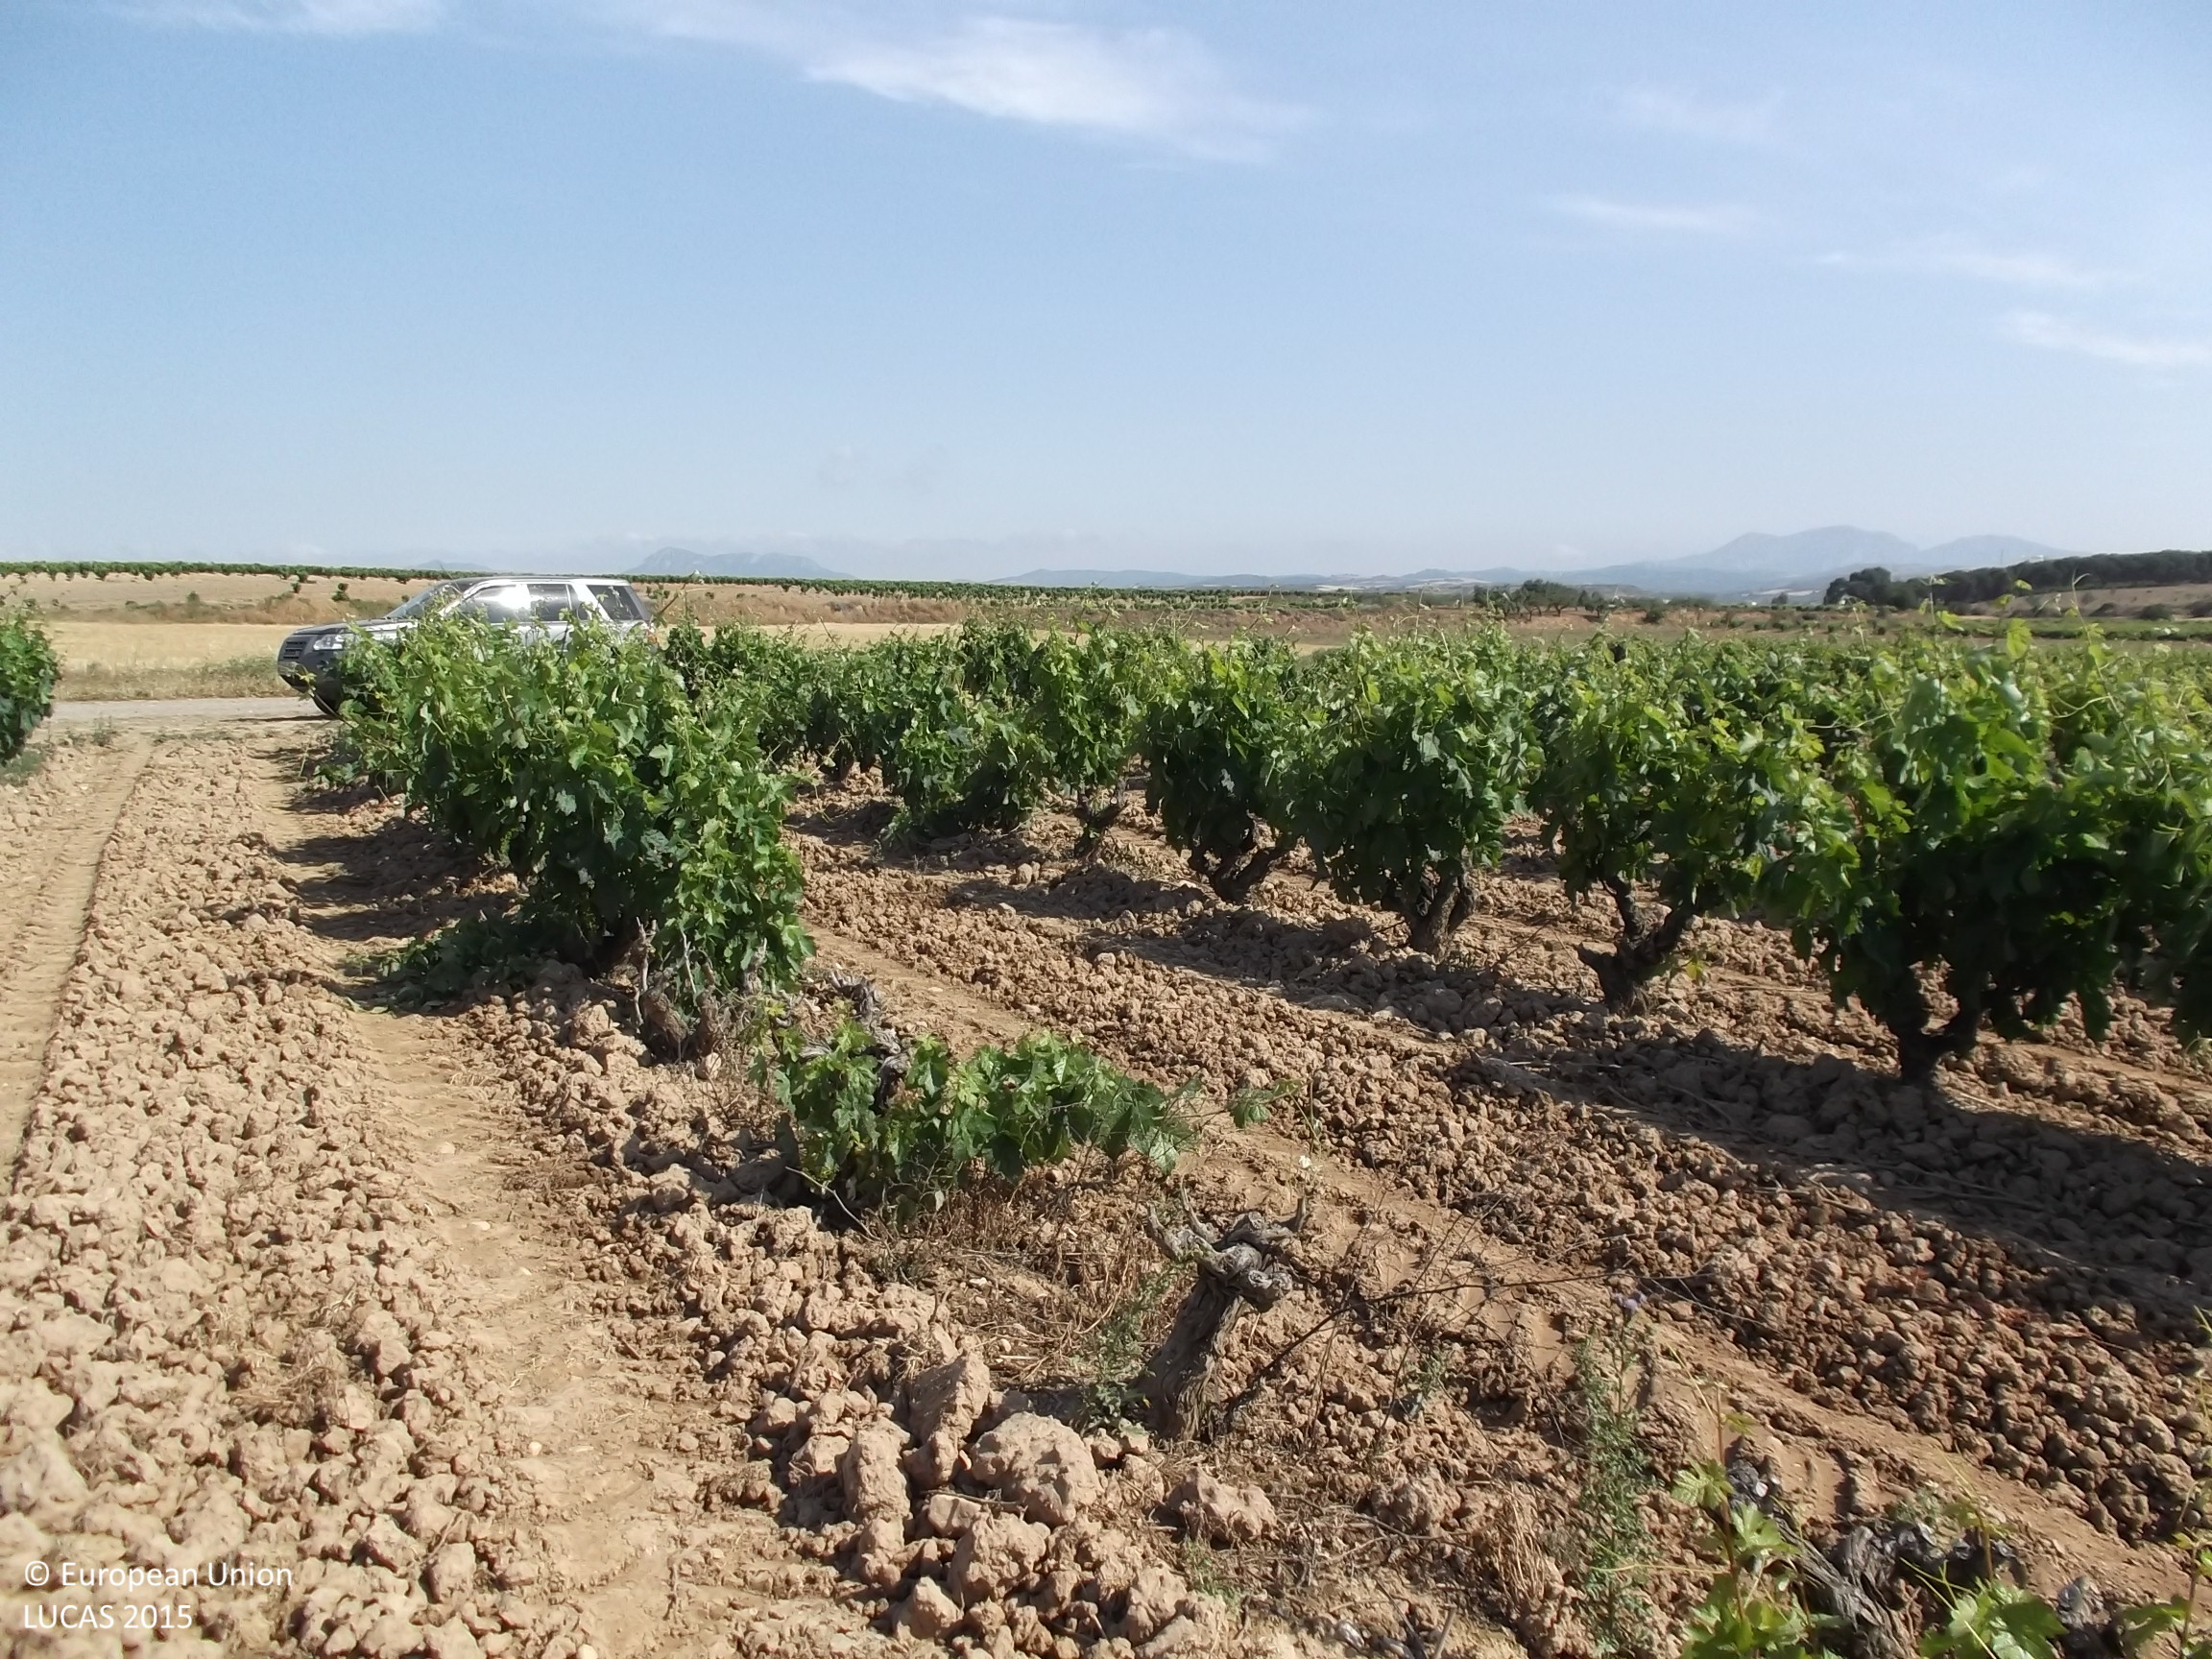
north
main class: Cropland
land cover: Vineyards
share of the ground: 25 - 50 %
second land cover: Other bare soil
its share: > 75 %
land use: Agriculture (excluding fallow land and kitchen gardens)
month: June
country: ES
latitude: 42.4918
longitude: -2.3939
